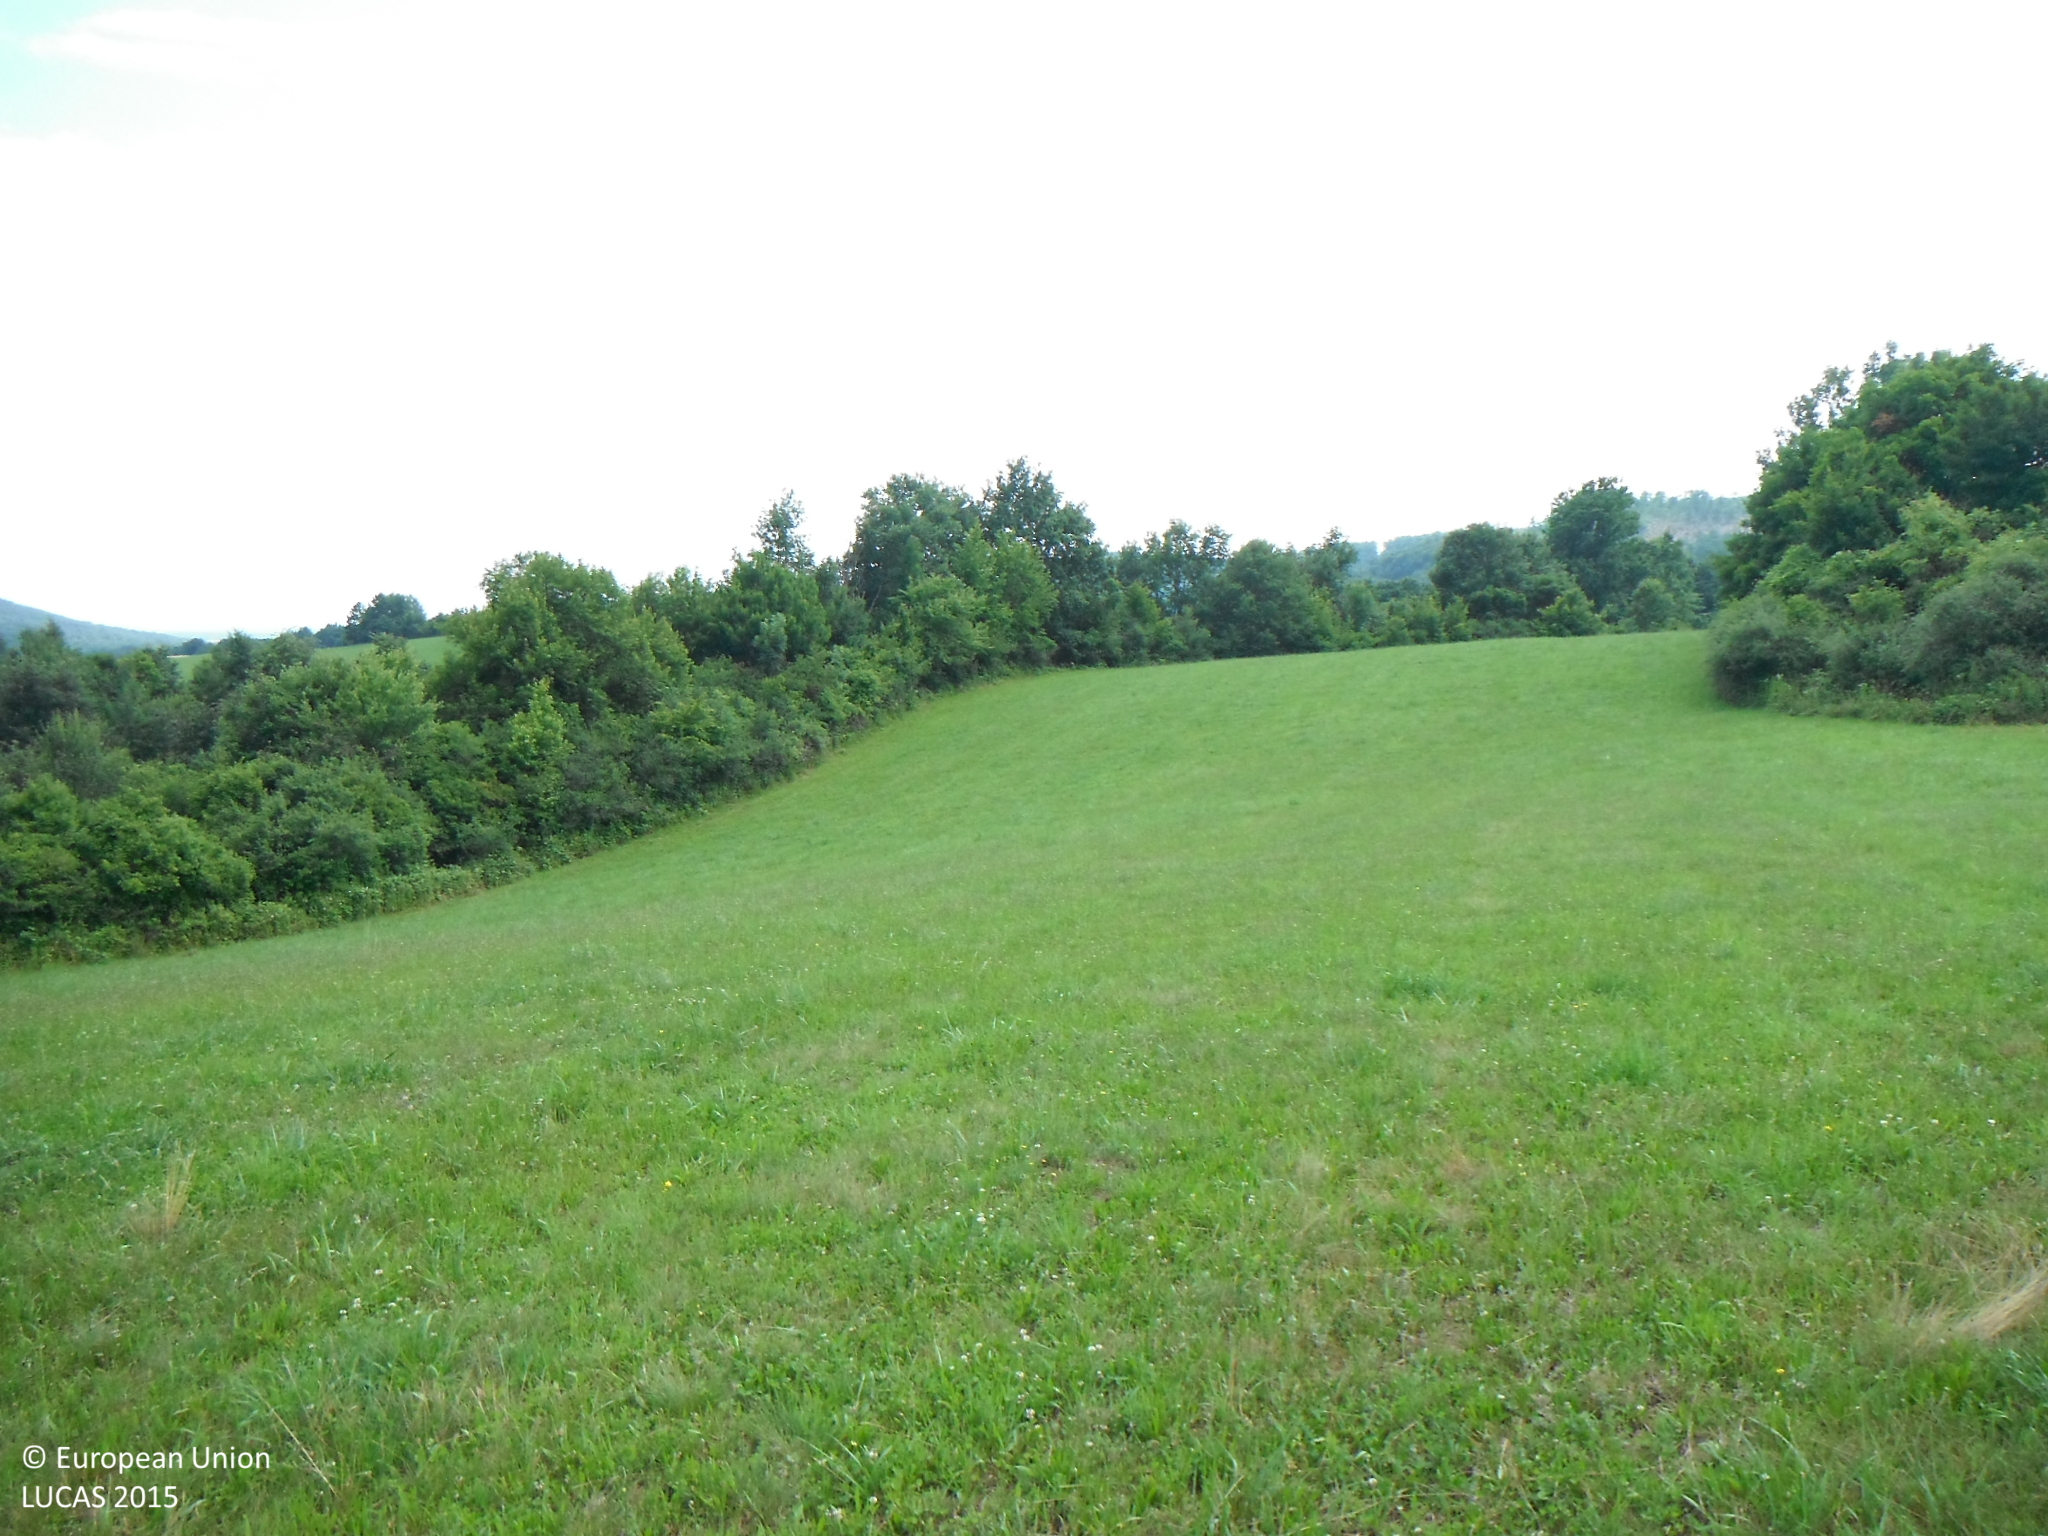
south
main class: Grassland
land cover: Grassland without tree/shrub cover
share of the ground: > 75 %
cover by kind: herbaceous plants 100 %
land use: Agriculture (excluding fallow land and kitchen gardens)
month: June
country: SK
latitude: 48.5259
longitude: 20.0365
